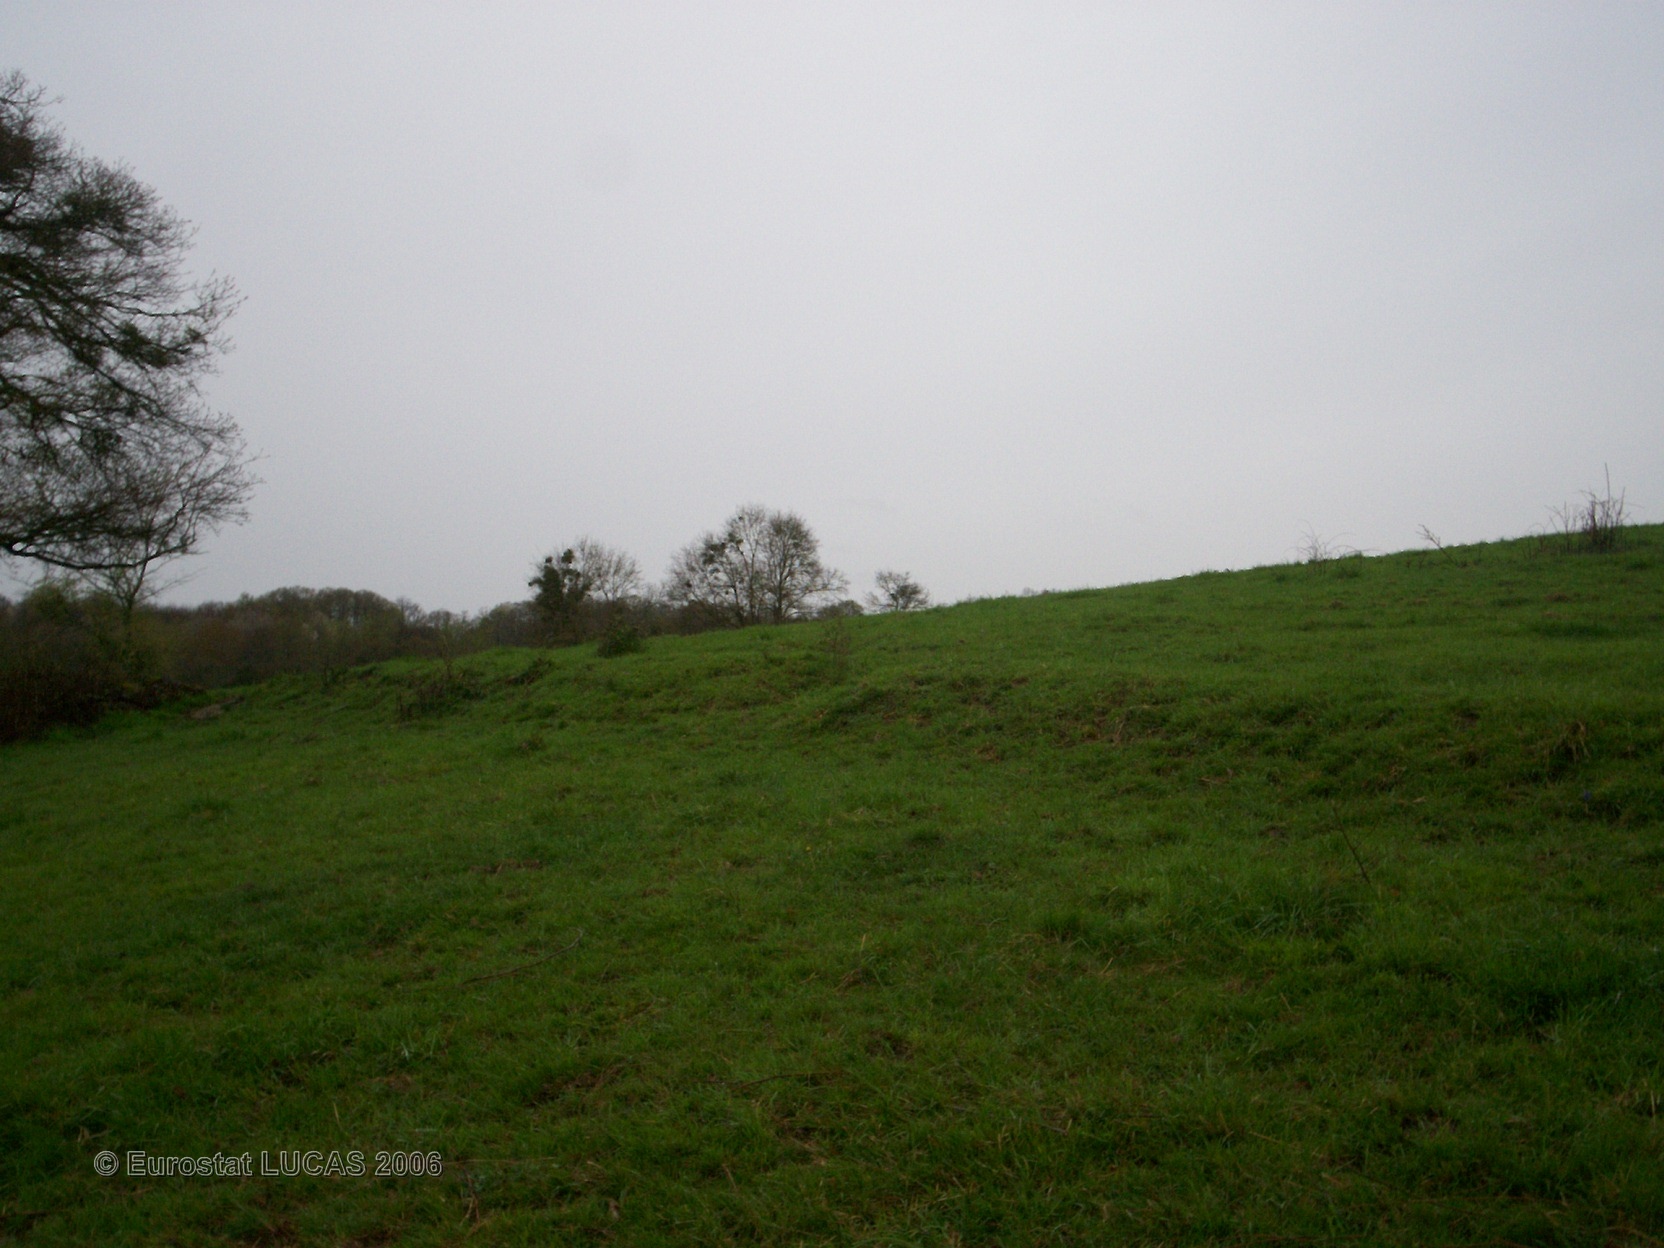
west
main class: Grassland
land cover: Grassland without tree/shrub cover
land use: Agriculture (excluding fallow land and kitchen gardens)
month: April
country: FR
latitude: 43.0612
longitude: 0.9044
